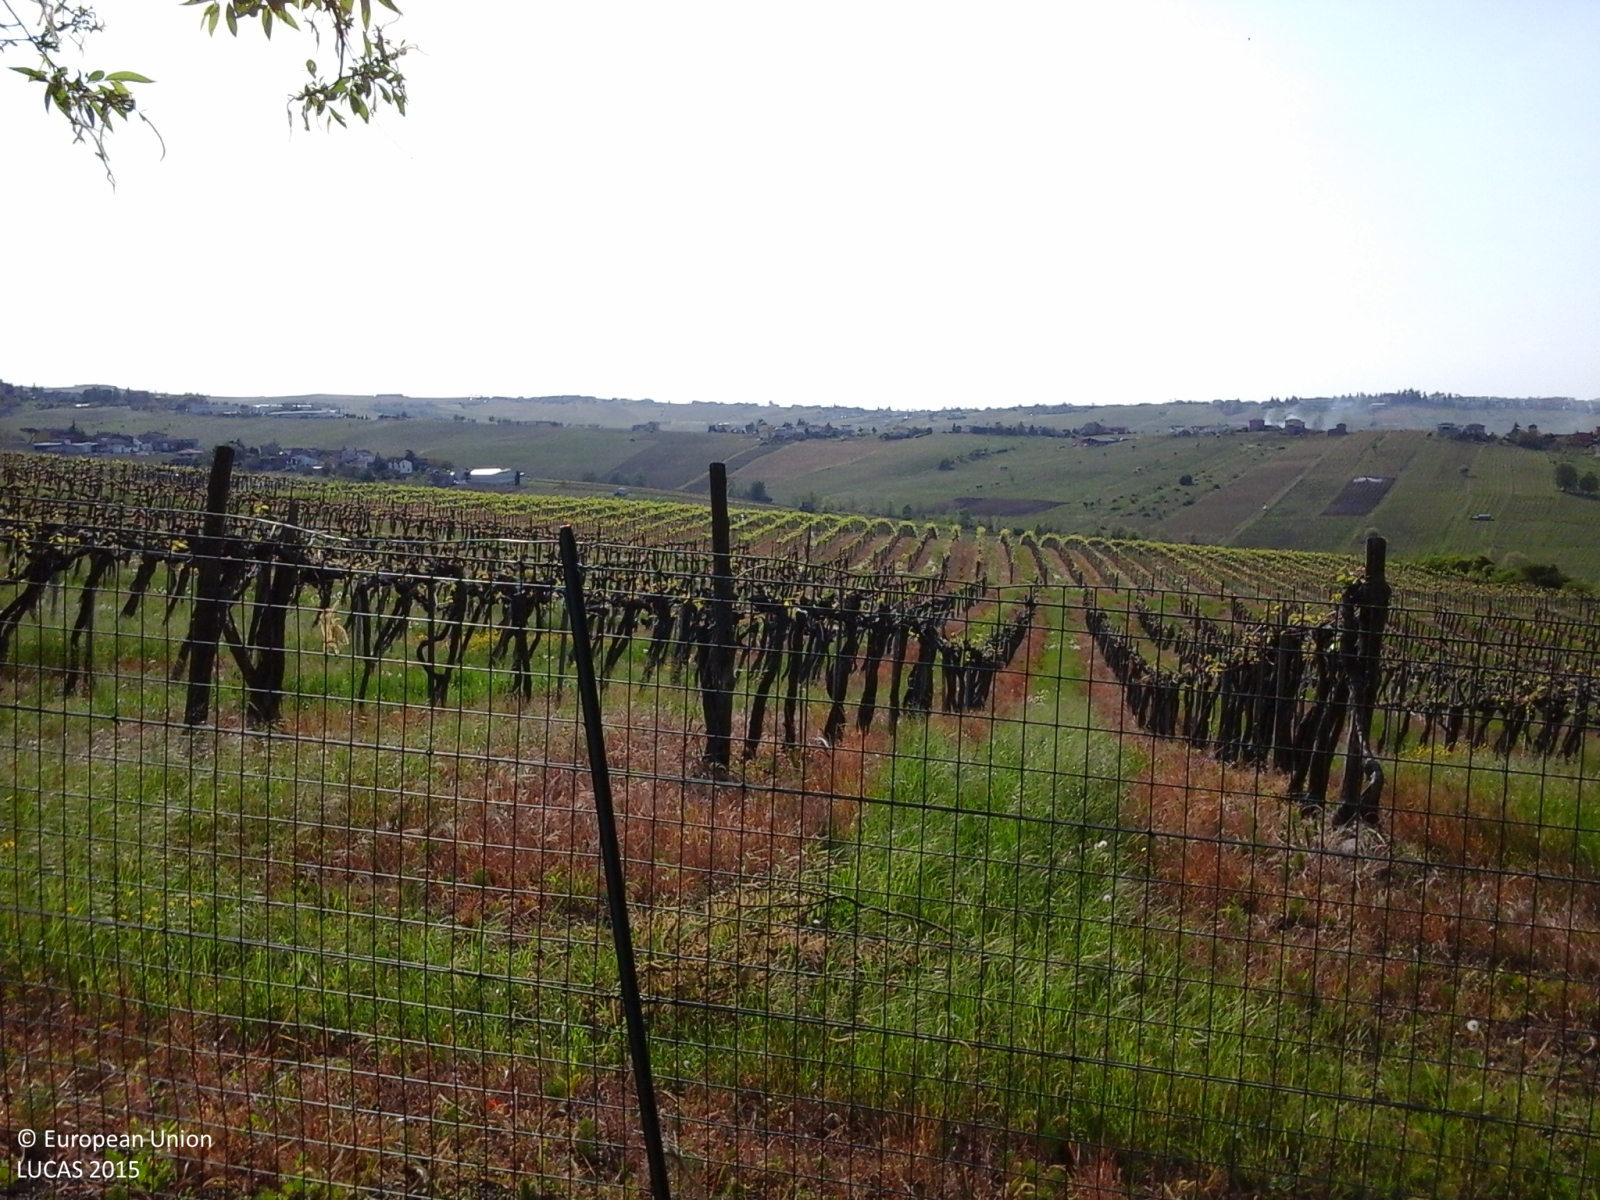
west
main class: Woodland
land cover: Broadleaved woodland
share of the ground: > 75 %
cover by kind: herbaceous plants 70 %, broadleaved forest trees 30 %
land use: Semi-natural and natural areas not in use
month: April
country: IT
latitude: 44.9979
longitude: 9.3796
